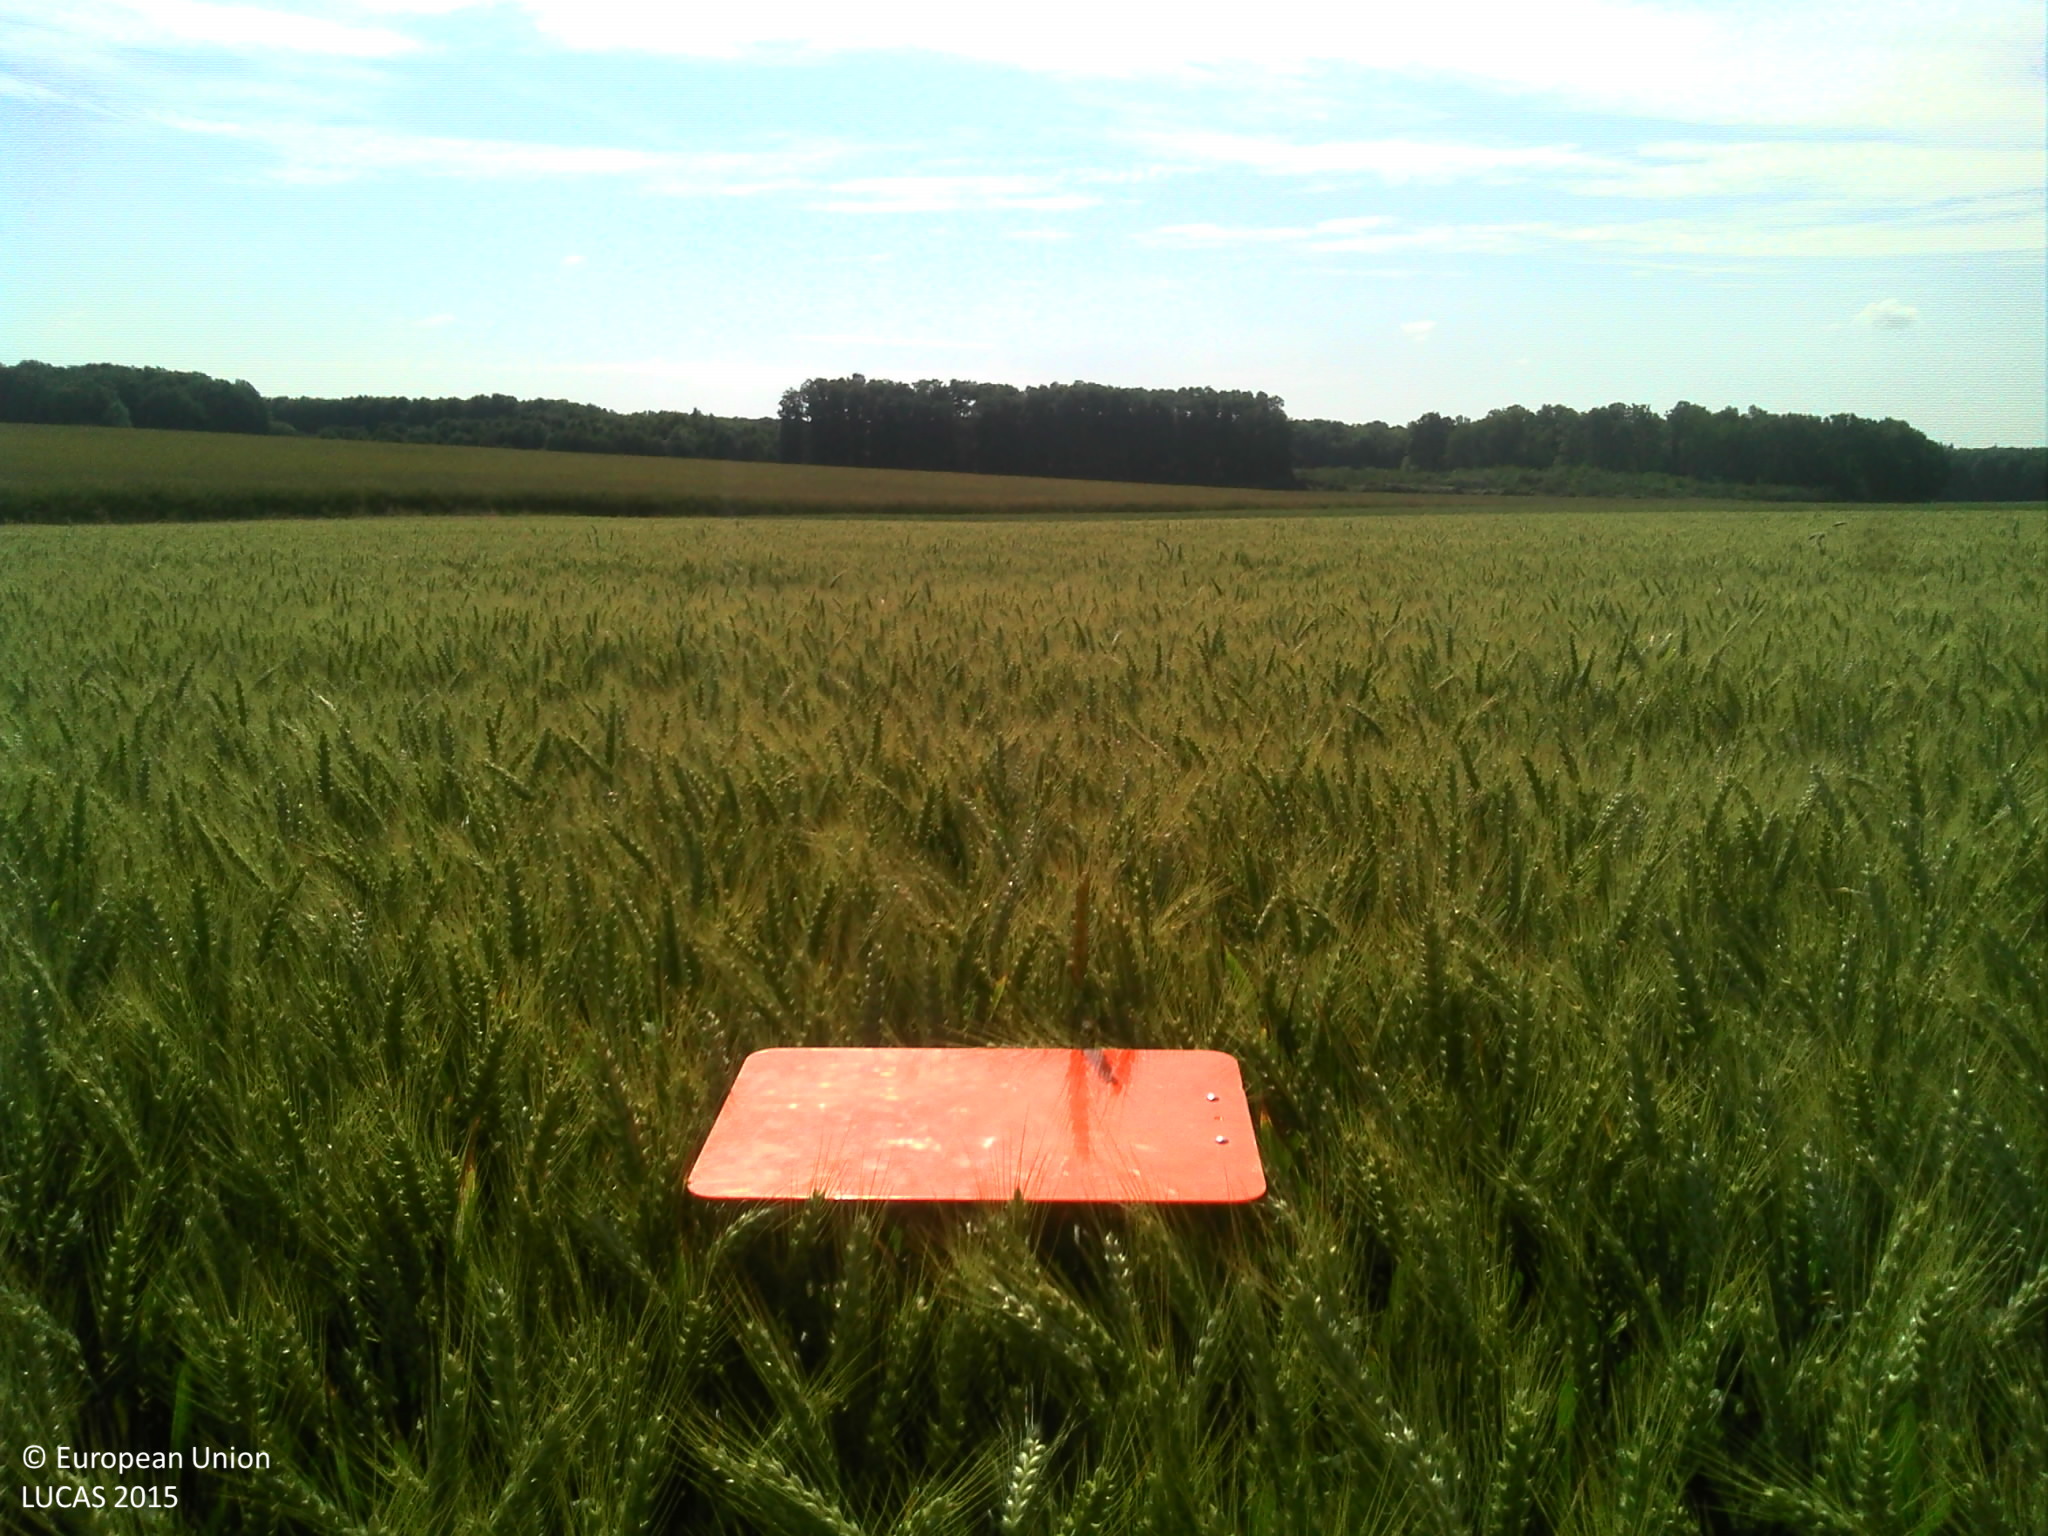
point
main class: Cropland
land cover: Common wheat
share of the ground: > 75 %
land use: Agriculture (excluding fallow land and kitchen gardens)
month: June
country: FR
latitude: 48.5391
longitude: 1.4090
